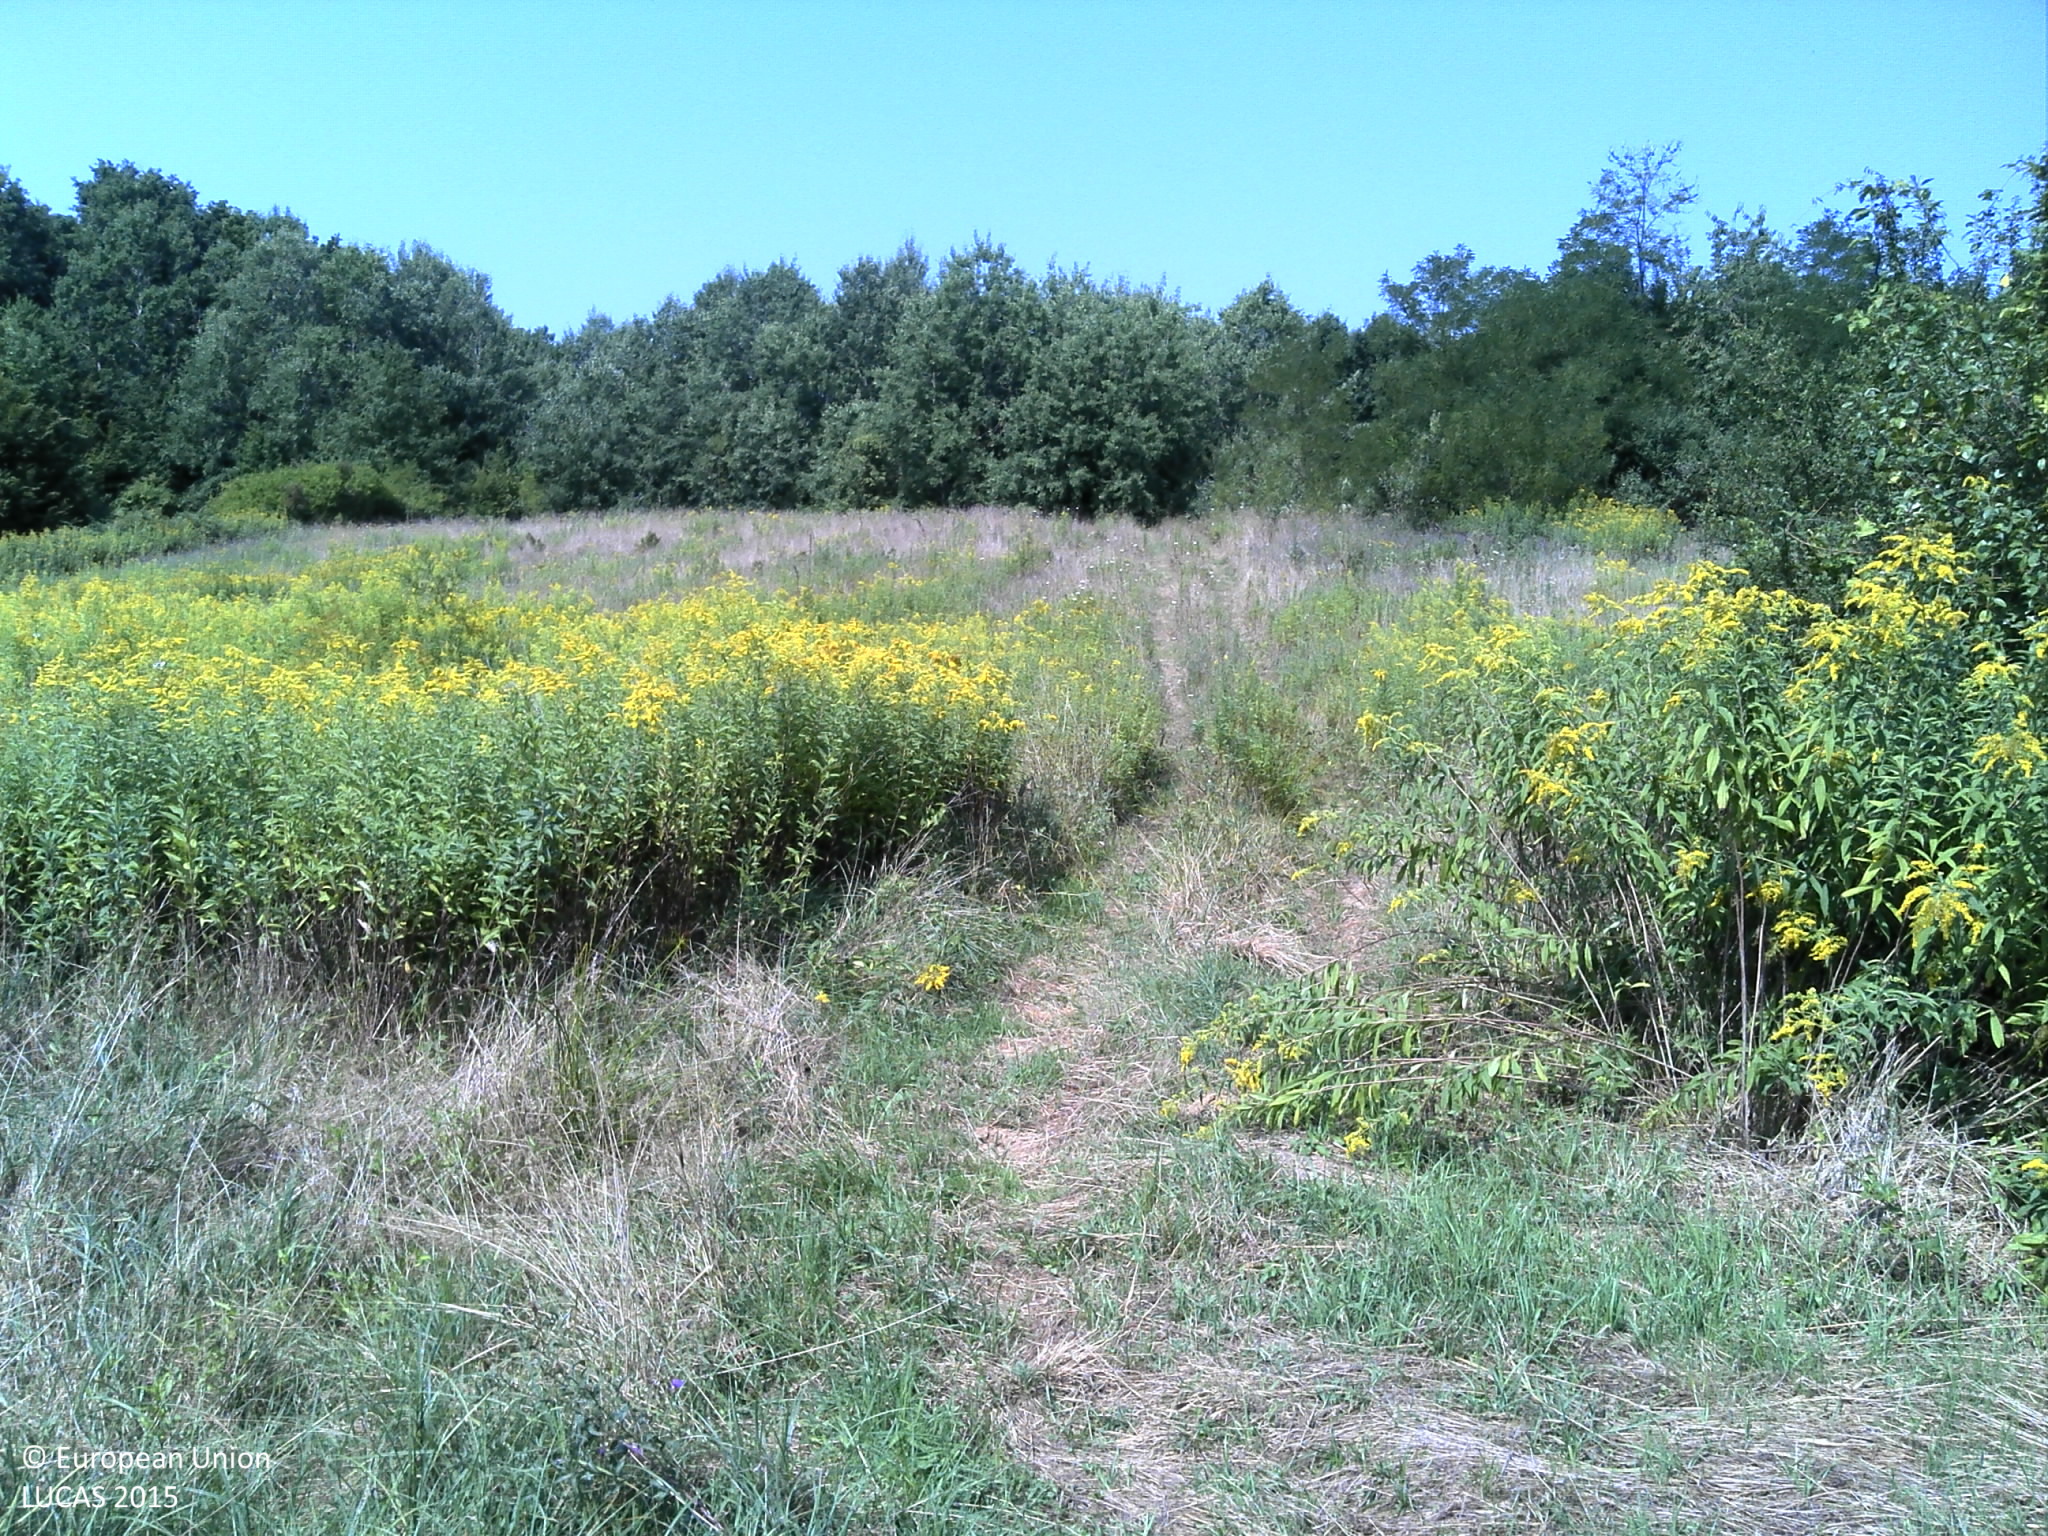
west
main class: Grassland
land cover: Spontaneously vegetated surfaces
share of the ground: > 75 %
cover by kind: herbaceous plants 100 %
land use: Agriculture (excluding fallow land and kitchen gardens)
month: August
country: HR
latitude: 45.5692
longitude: 16.8803
